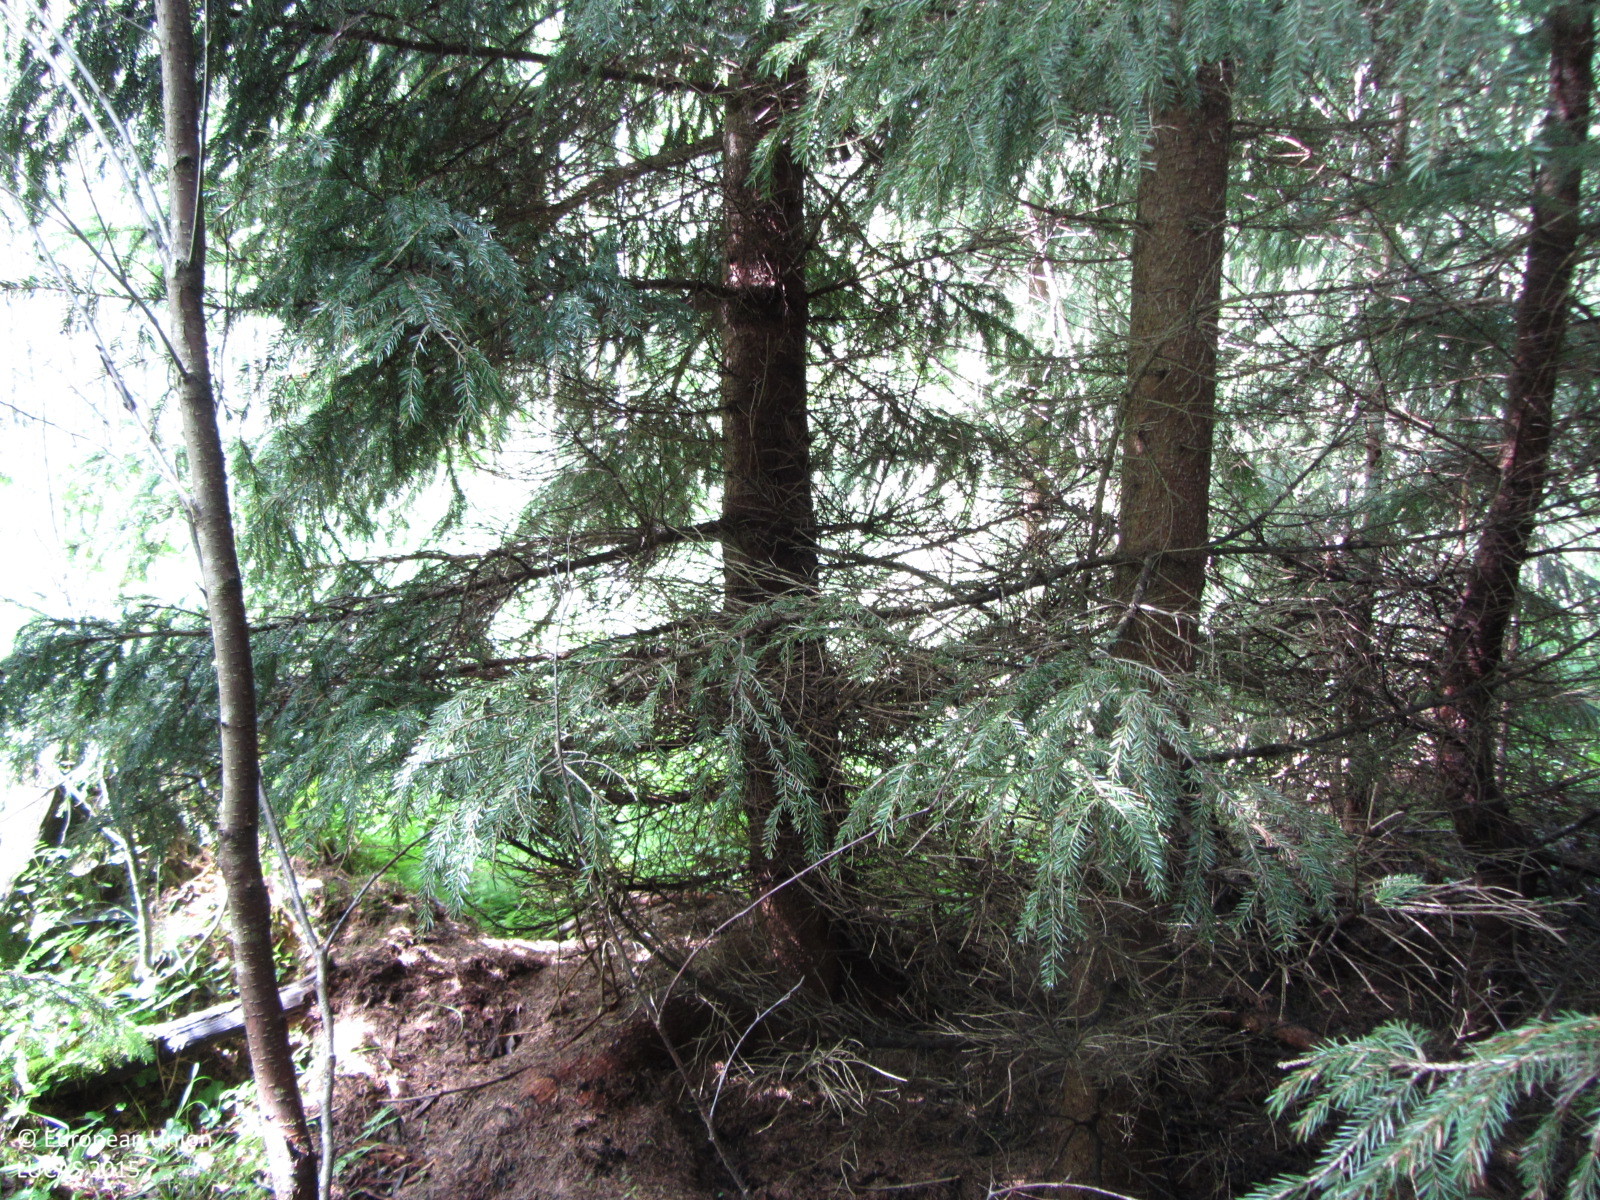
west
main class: Woodland
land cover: Spruce dominated mixed woodland
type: hemiboreal forest and nemoral coniferous forest and mixed broadleaved-coniferous forest
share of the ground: > 75 %
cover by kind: coniferous forest trees 45 %, broadleaved forest trees 45 %, herbaceous plants 10 %
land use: Forestry
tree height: > 5 m
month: July
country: FI
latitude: 60.1593
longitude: 24.5043
